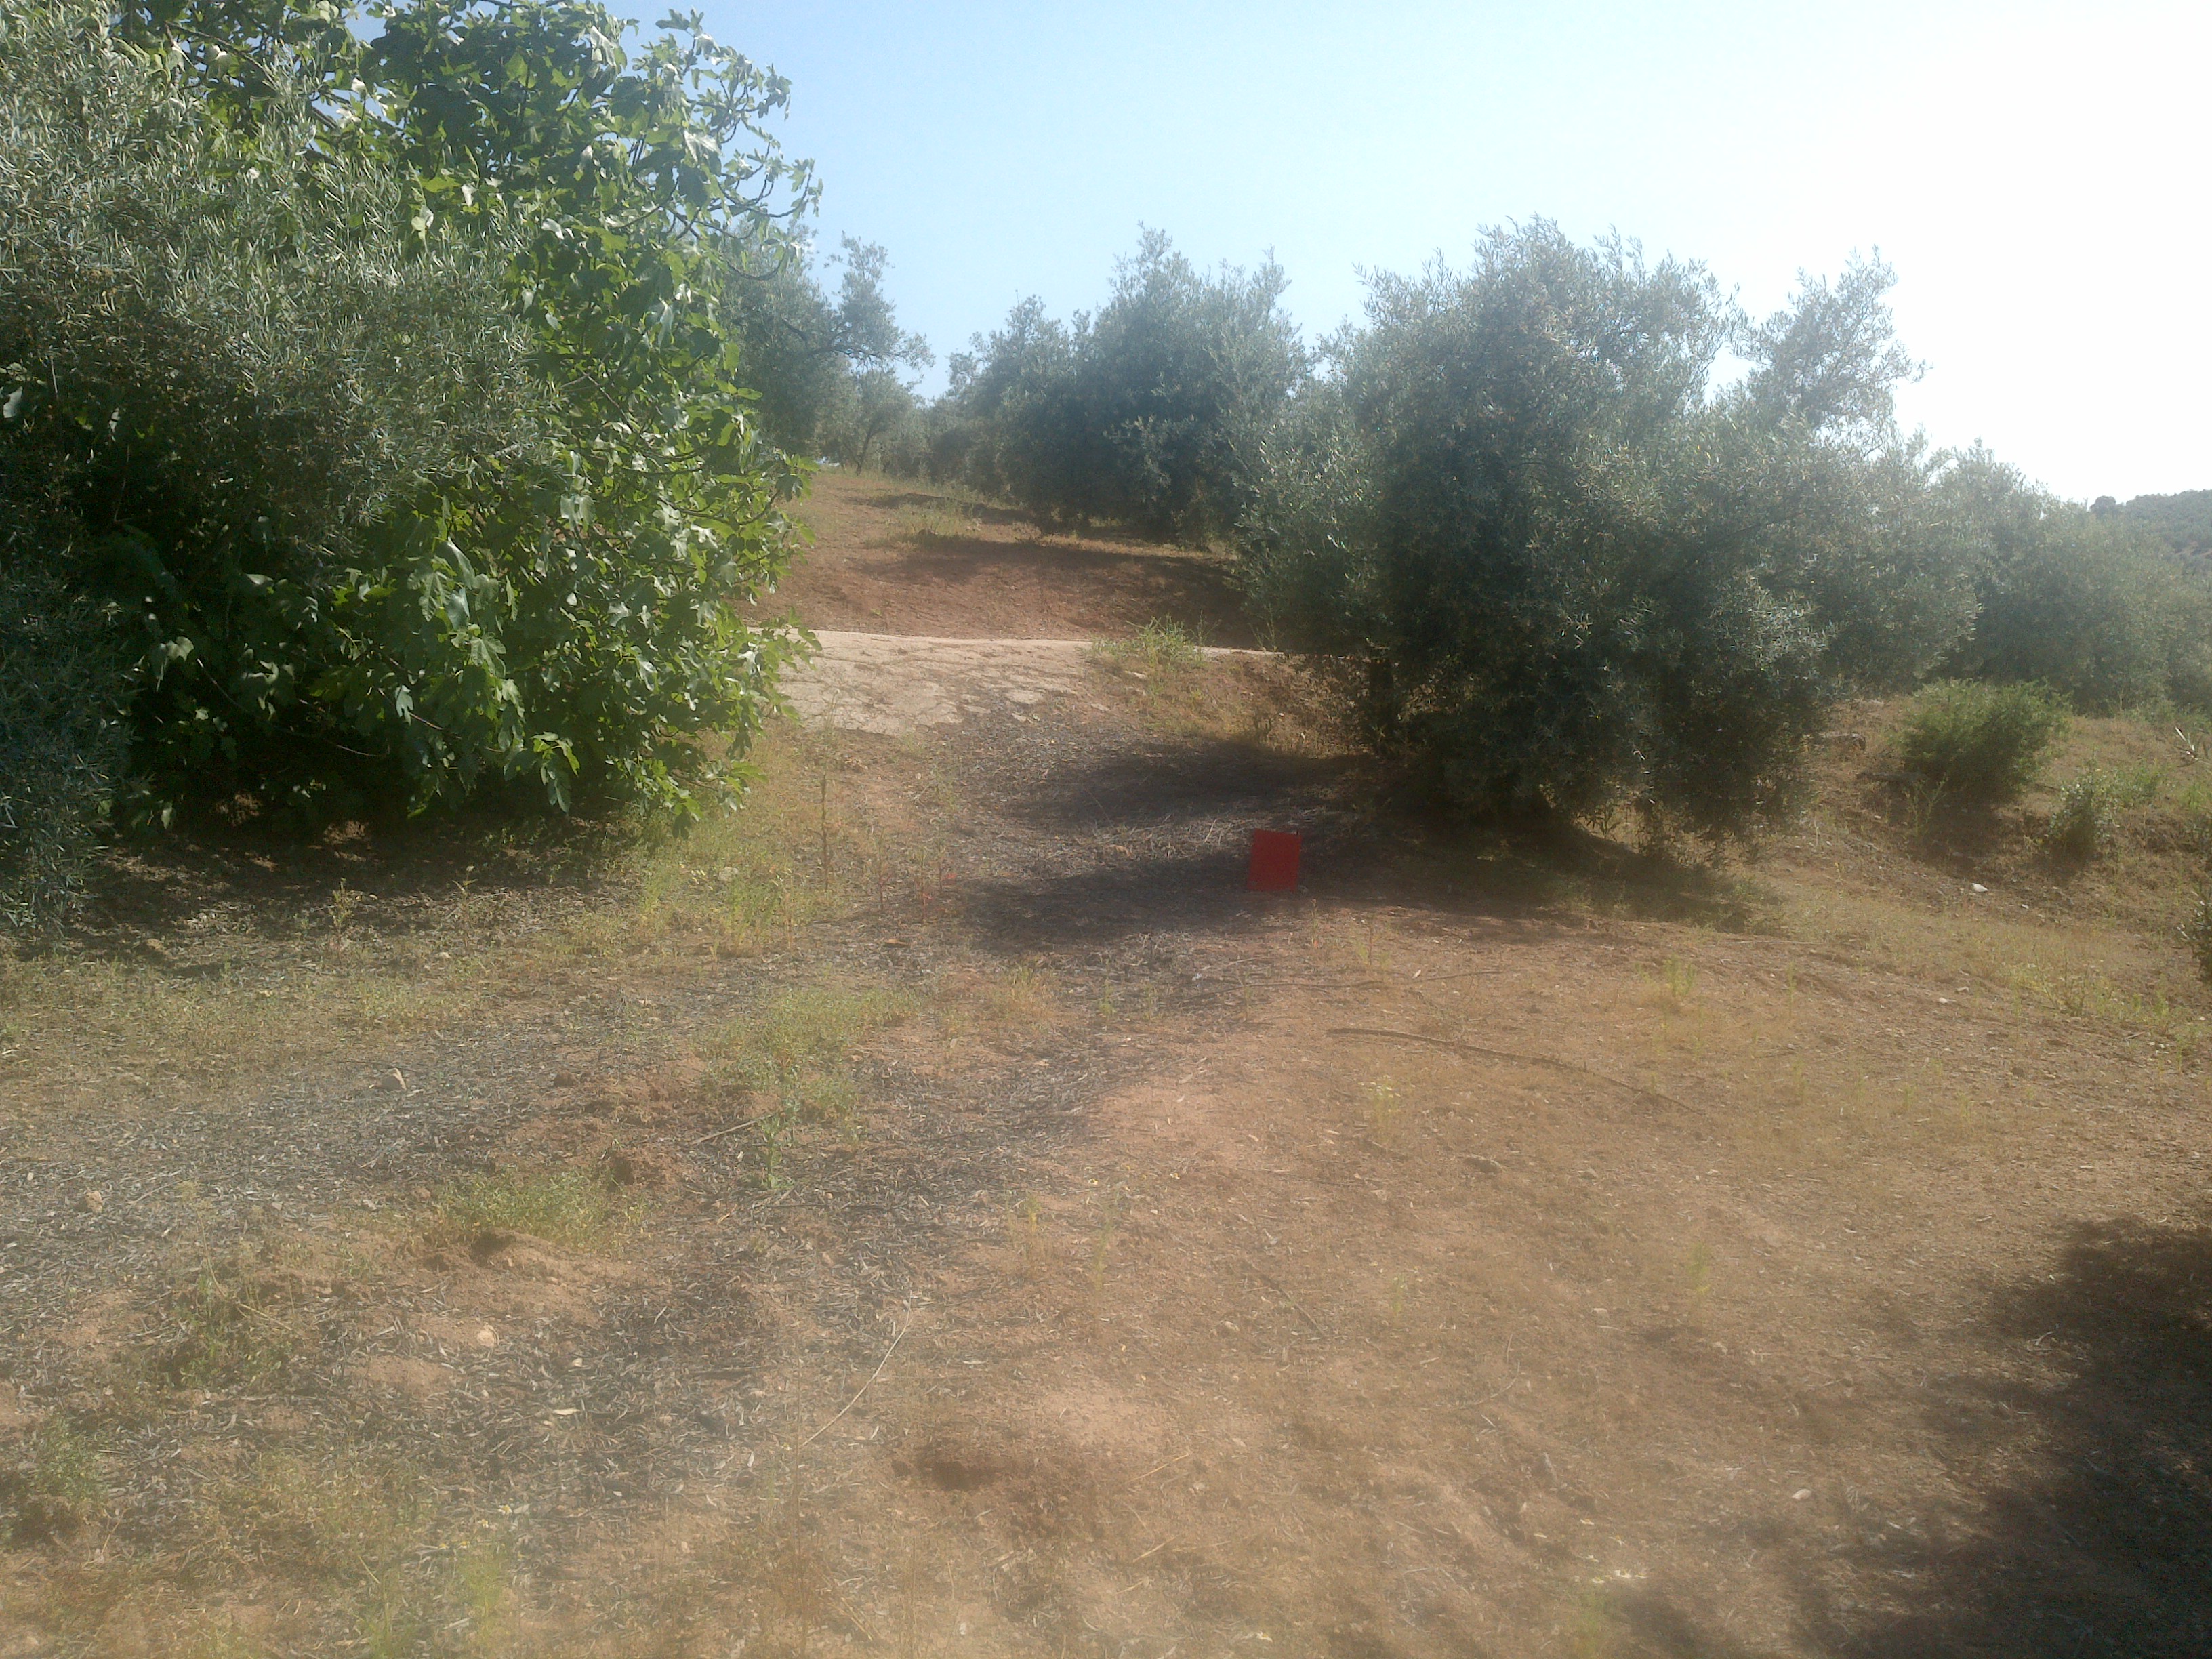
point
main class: Cropland
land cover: Olive groves
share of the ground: 25 - 50 %
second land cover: Spontaneously vegetated surfaces
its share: 10 - 25 %
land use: Agriculture (excluding fallow land and kitchen gardens)
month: May
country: ES
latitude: 37.4519
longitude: -4.4154
